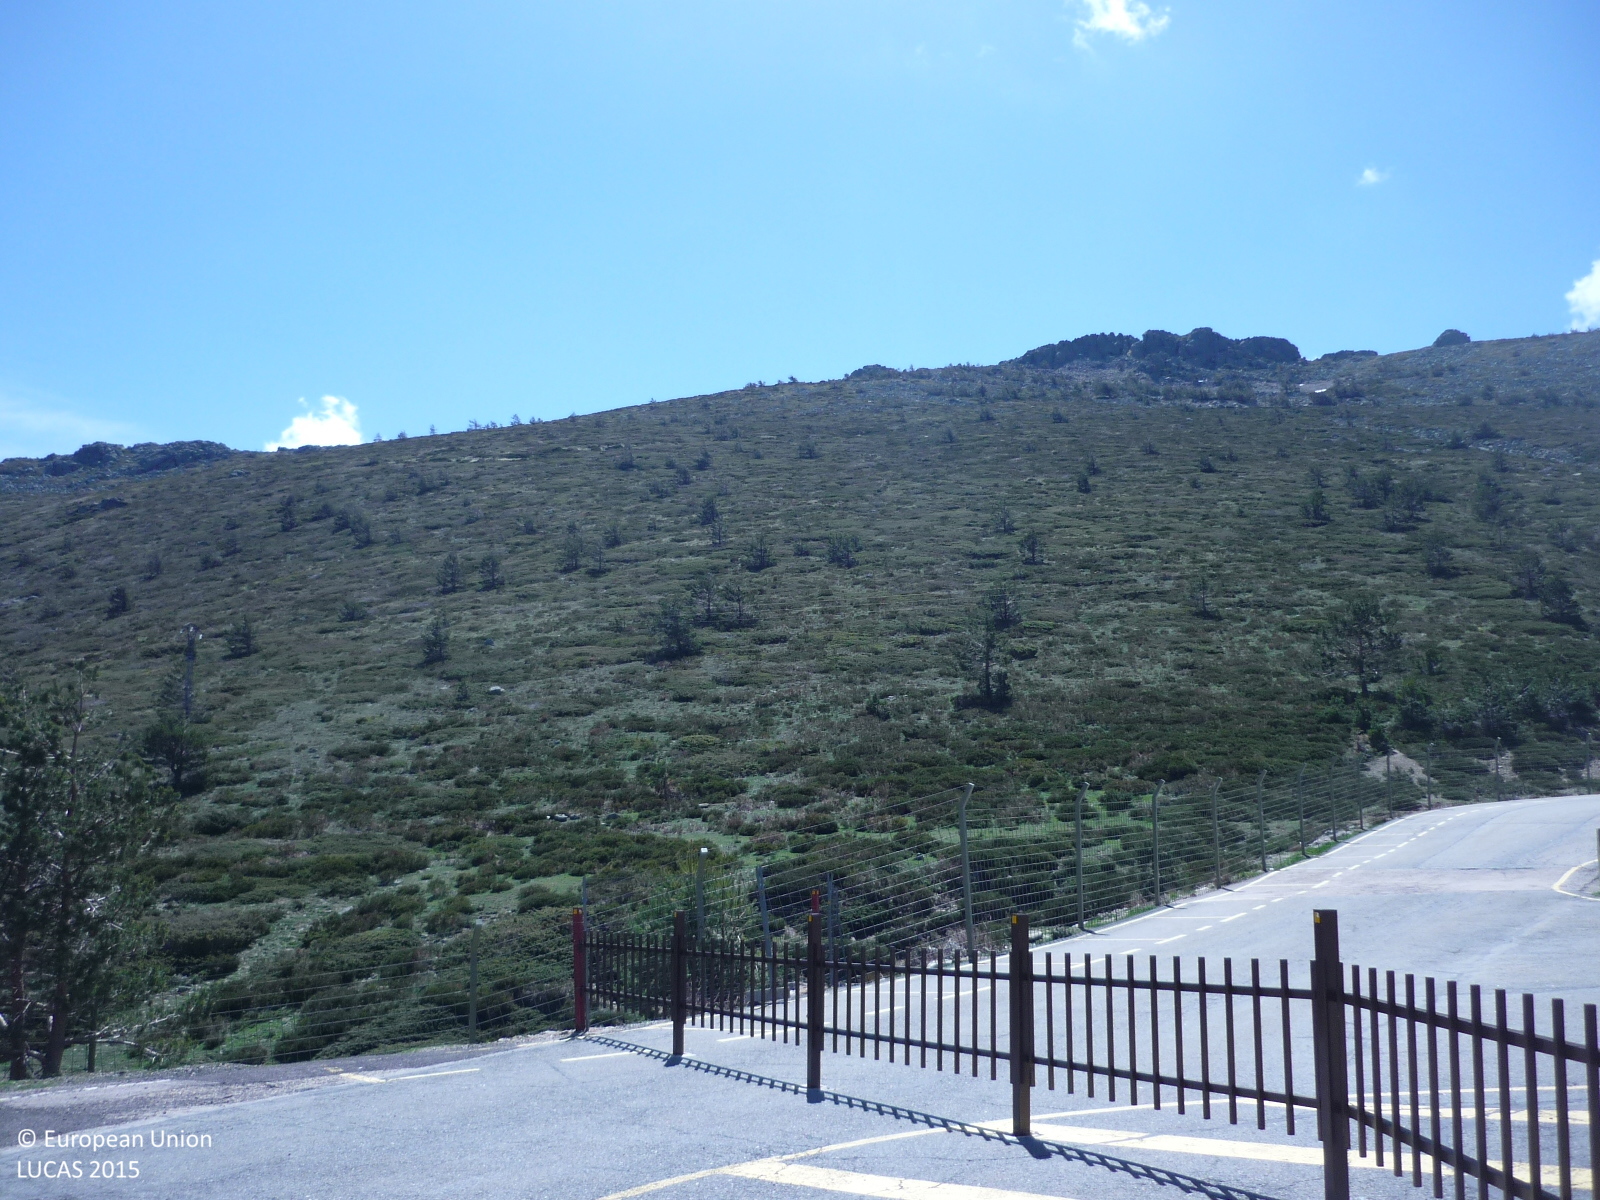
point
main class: Woodland
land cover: Pine dominated coniferous woodland
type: coniferous forest of the mediterranean region
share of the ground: > 75 %
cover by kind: coniferous forest trees 75 %, herbaceous plants 25 %
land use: Forestry
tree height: > 5 m
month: May
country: ES
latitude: 40.8045
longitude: -3.9502
